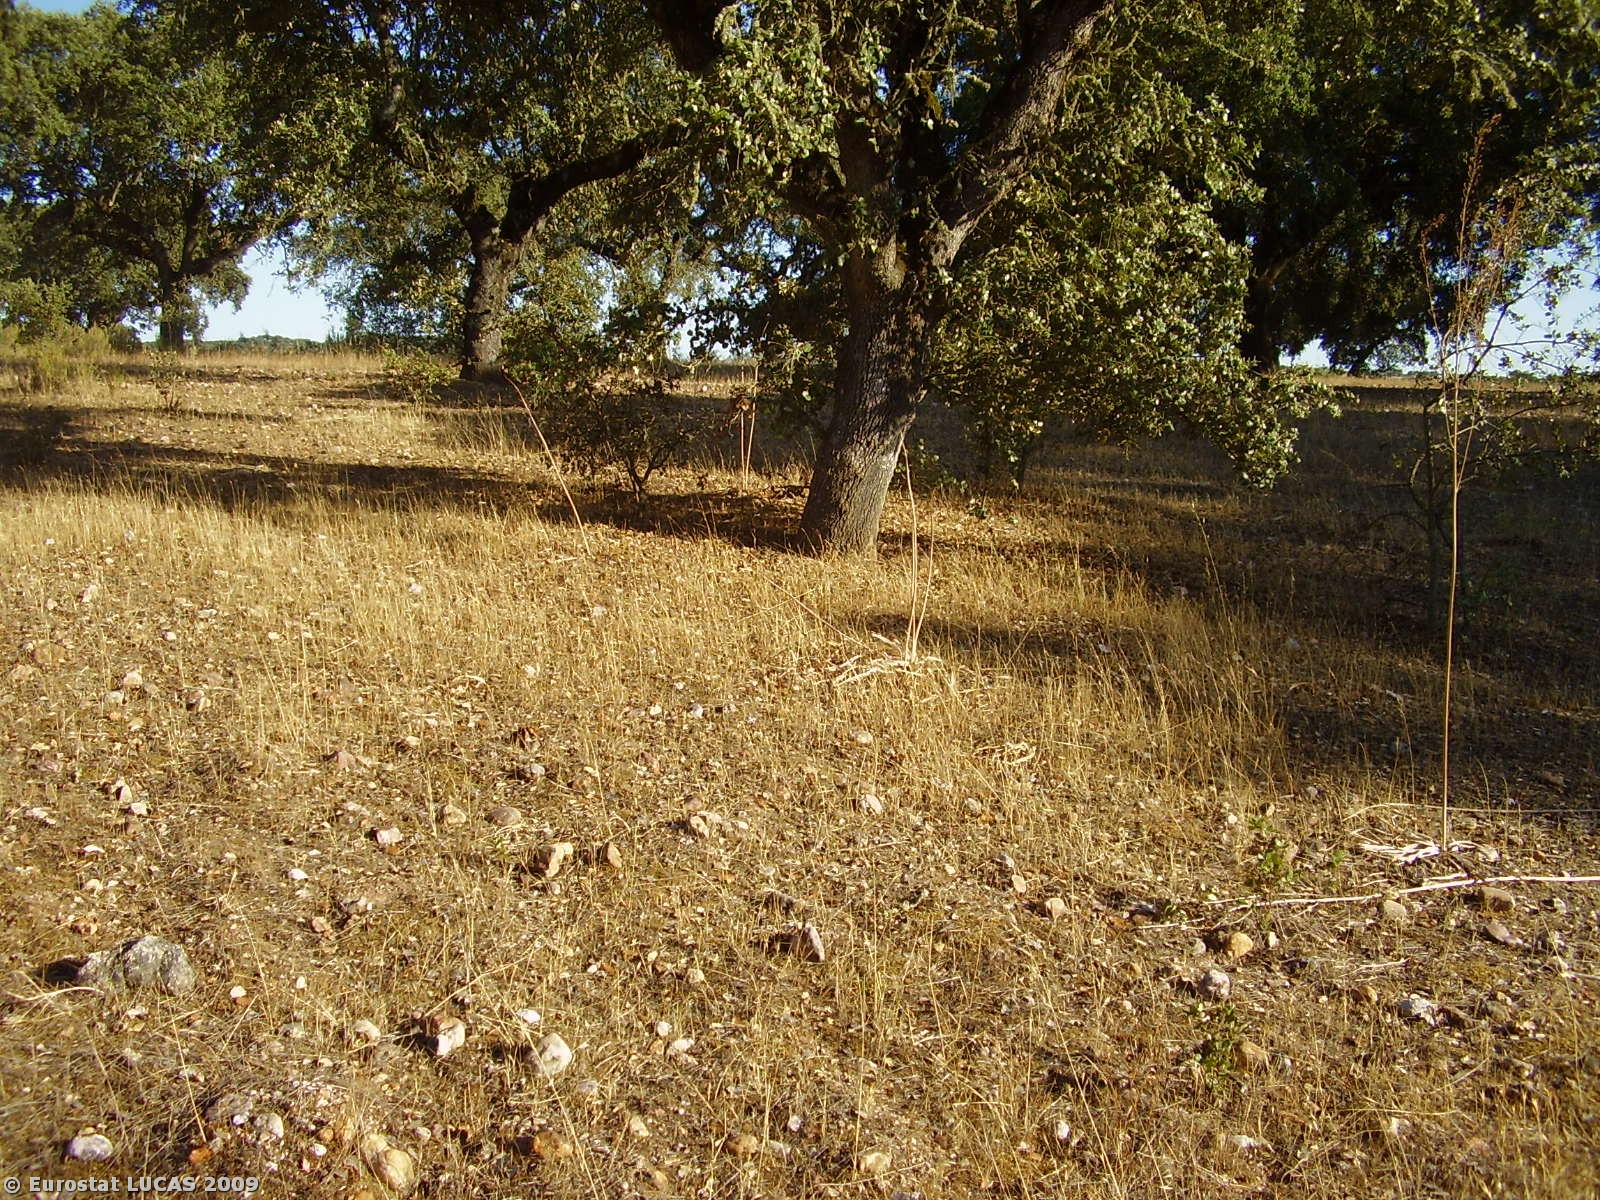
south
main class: Woodland
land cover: Broadleaved woodland
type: broadleaved evergreen forest
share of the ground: 25 - 50 %
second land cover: Spontaneously vegetated surfaces
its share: 10 - 25 %
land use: Forestry
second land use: Fallow land
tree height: > 5 m
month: July
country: PT
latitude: 38.9318
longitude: -8.0335
